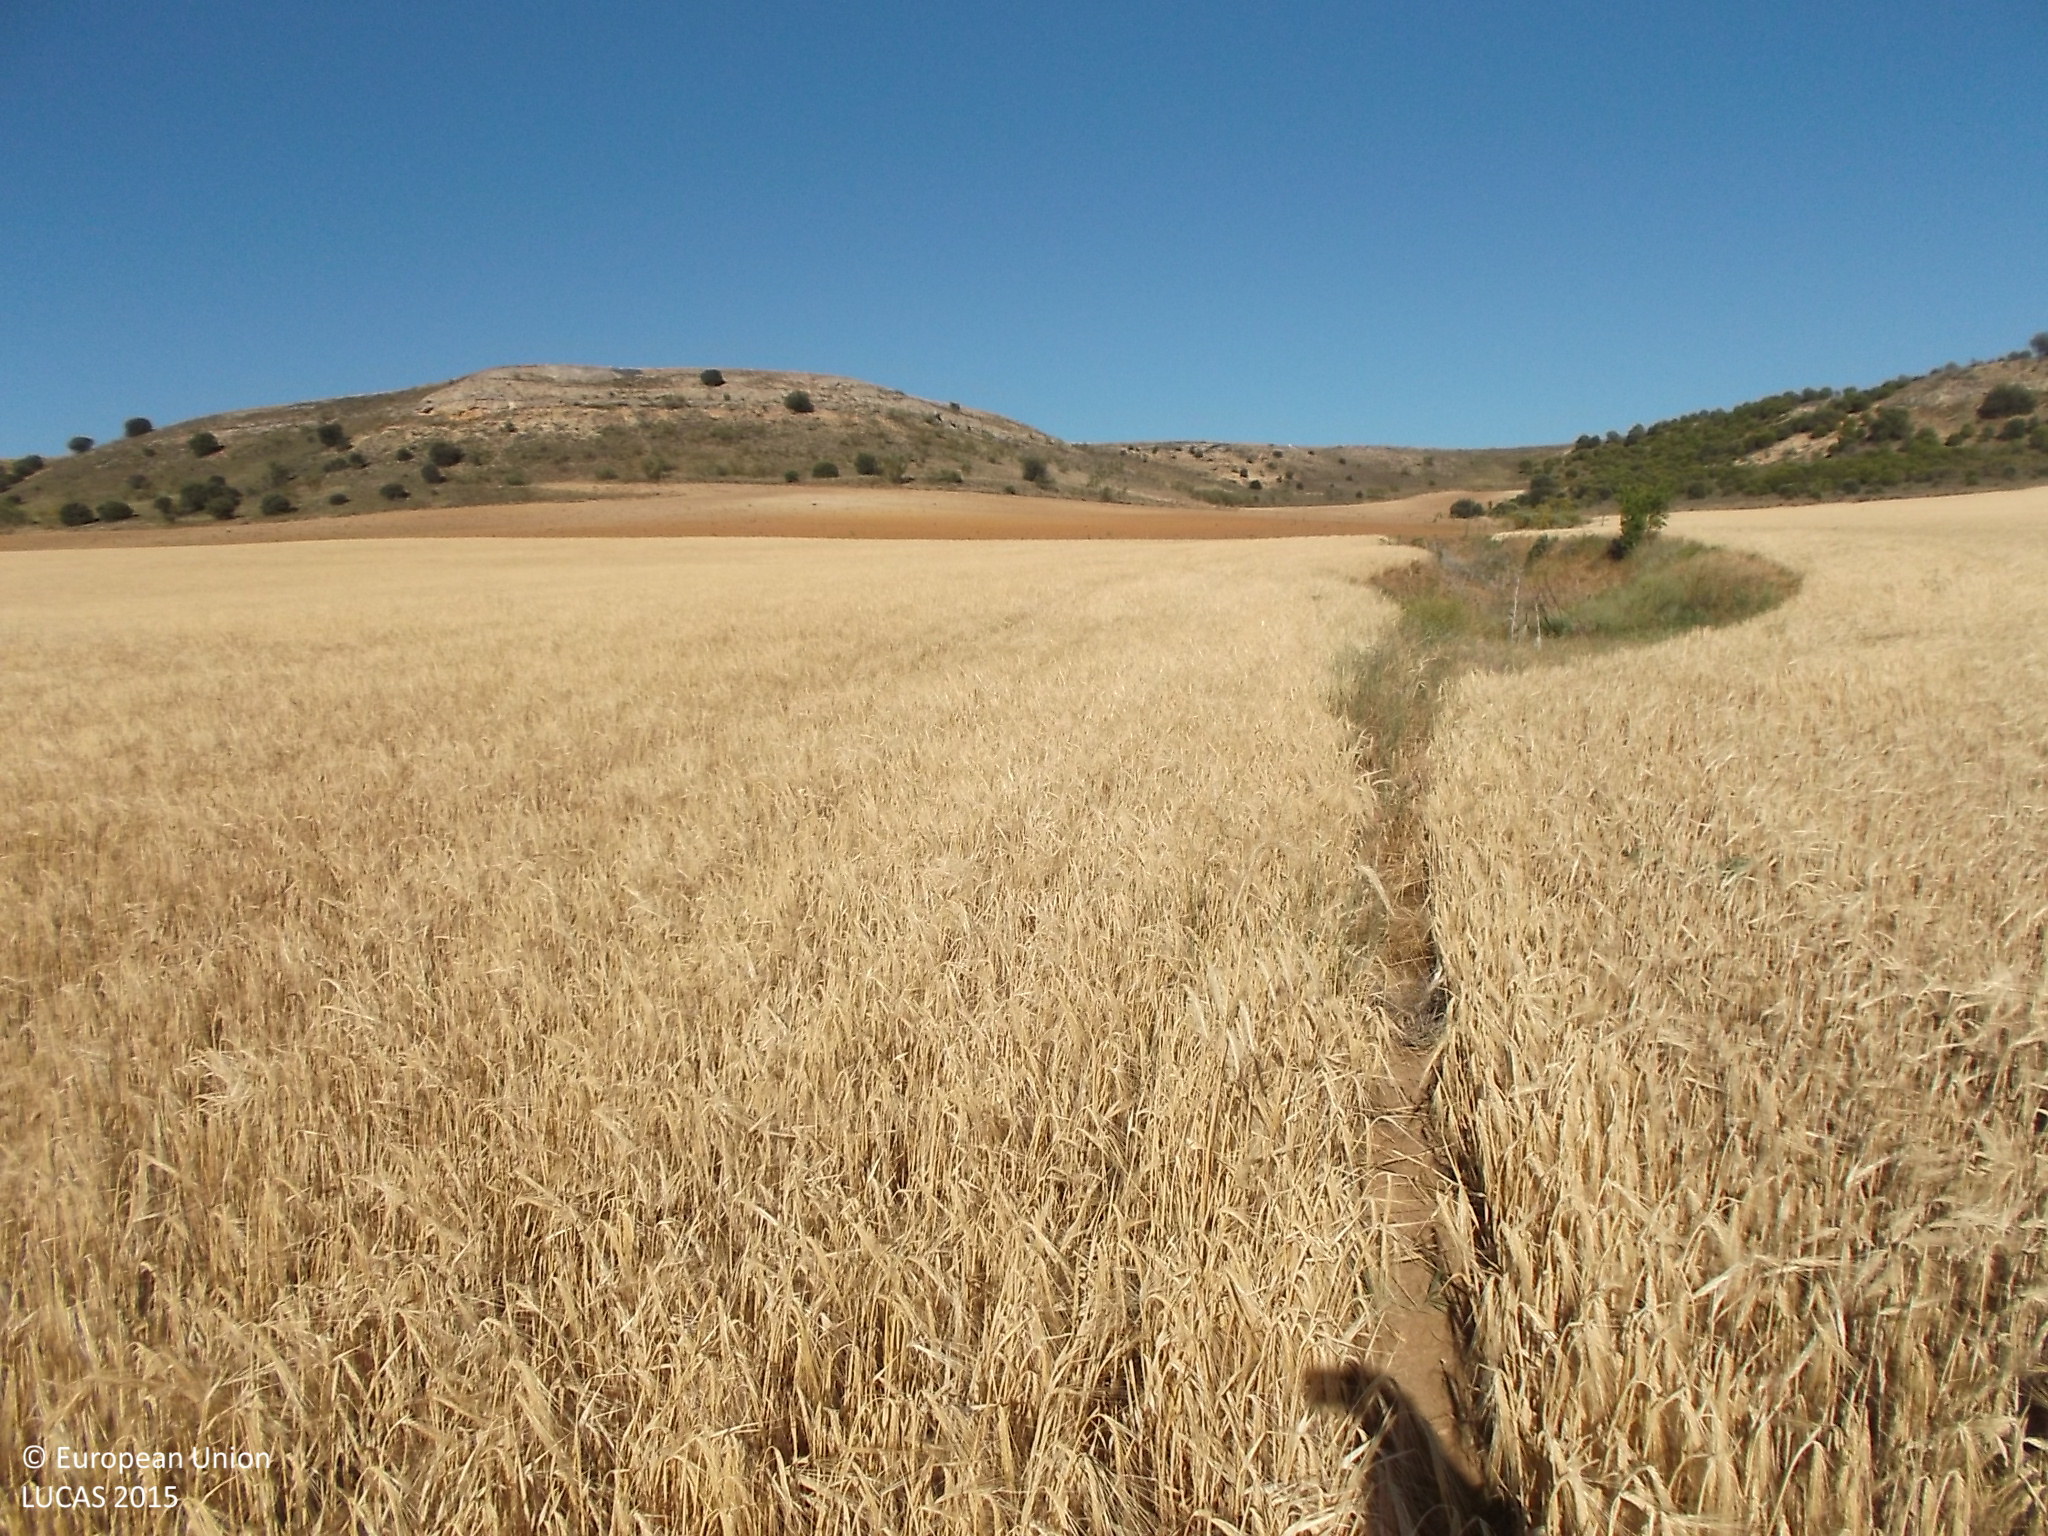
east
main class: Cropland
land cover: Barley
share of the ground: > 75 %
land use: Agriculture (excluding fallow land and kitchen gardens)
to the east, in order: Barley; Grassland without tree/shrub cover; Ditches and canals; Other bare soil
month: June
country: ES
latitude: 41.2962
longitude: -5.3254
